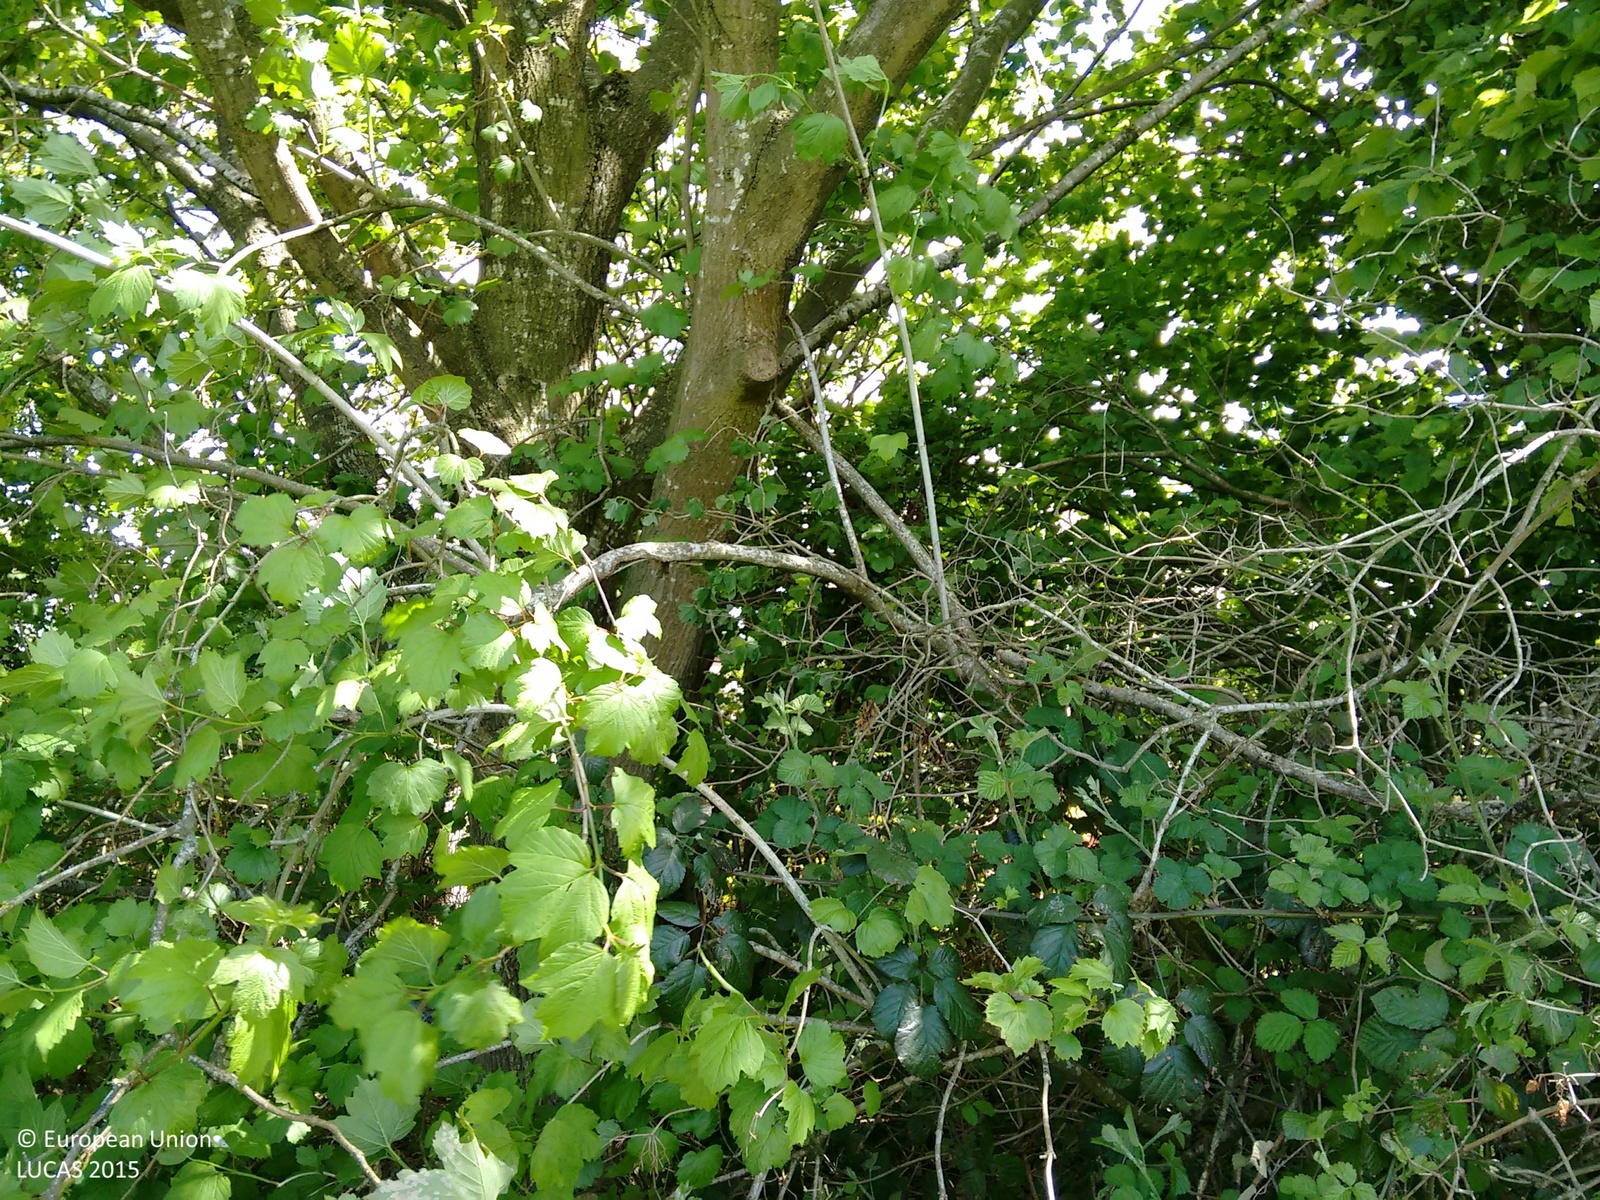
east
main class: Woodland
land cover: Broadleaved woodland
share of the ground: > 75 %
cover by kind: broadleaved forest trees 85 %, shrubs 15 %
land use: Residential
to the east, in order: Broadleaved woodland; Artificial constructions in urban areas; Broadleaved woodland; Rivers and streams; Broadleaved woodland; Fences; Broadleaved woodland
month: May
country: GB
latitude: 51.3549
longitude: -1.2047
